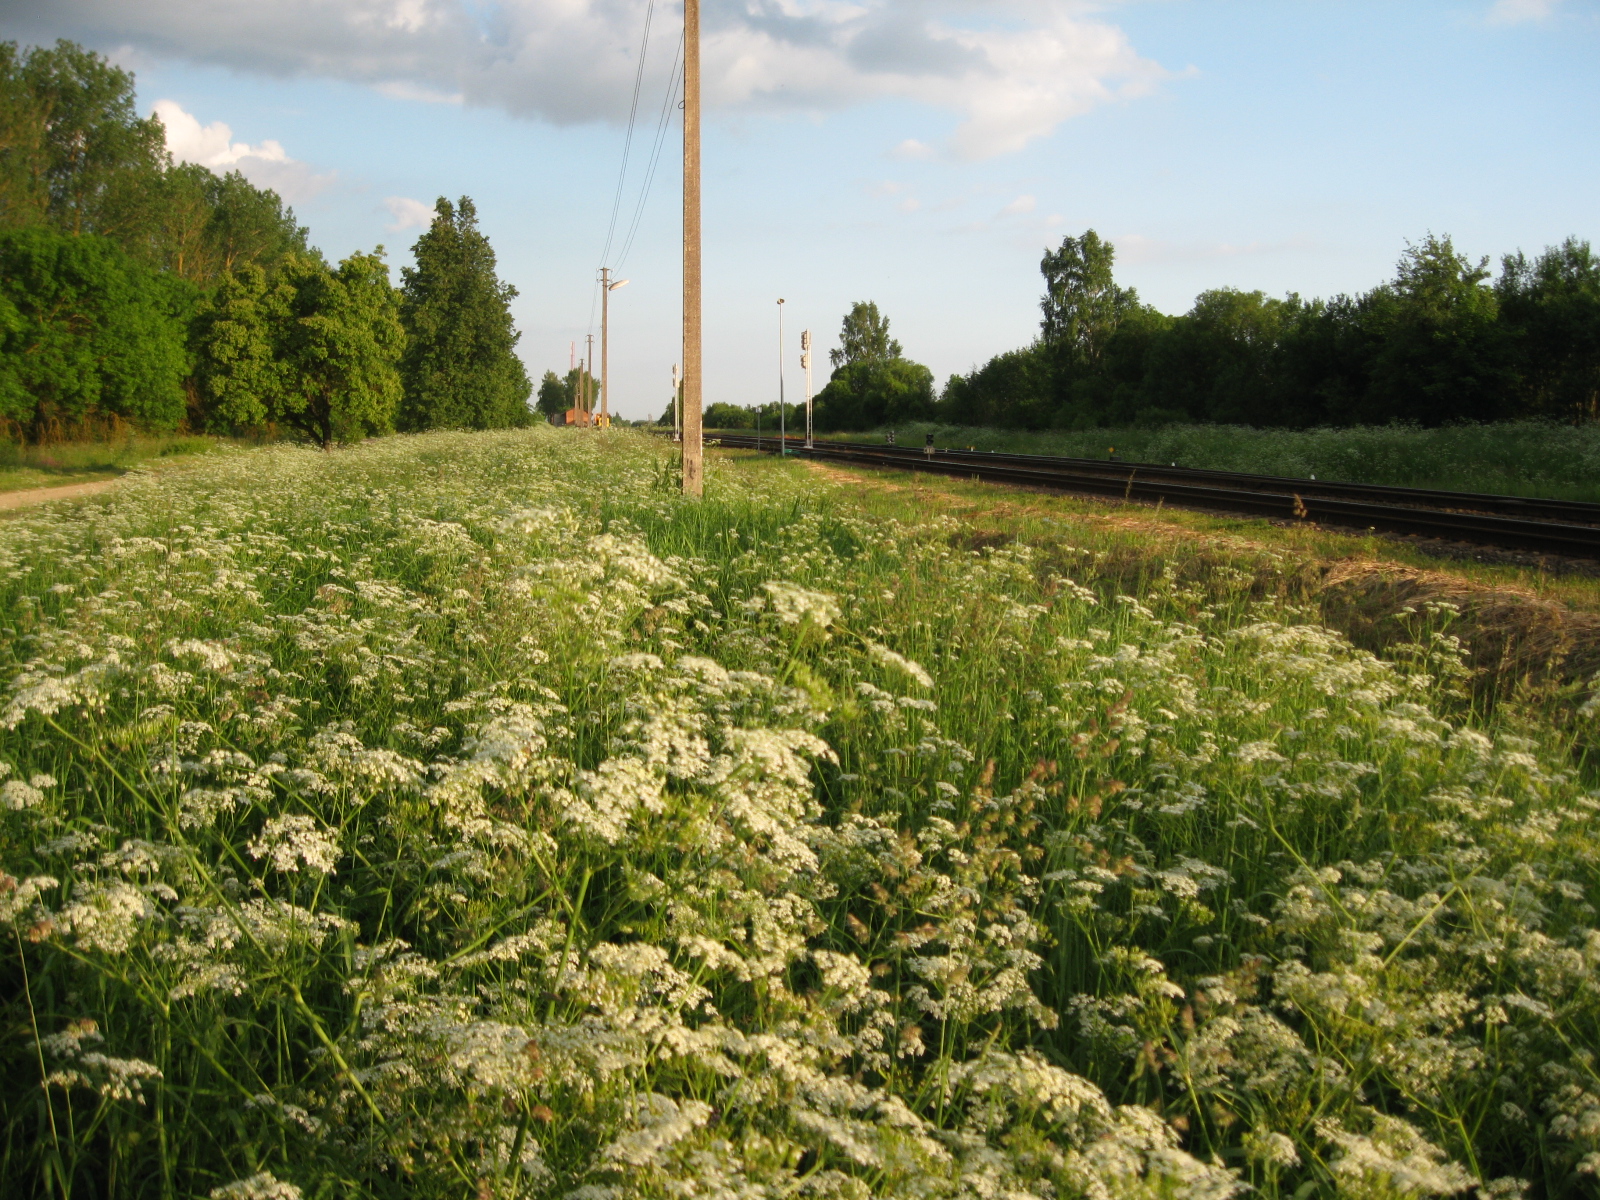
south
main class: Grassland
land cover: Spontaneously vegetated surfaces
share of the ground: > 75 %
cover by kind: herbaceous plants 100 %
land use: Railway transport
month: June
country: LT
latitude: 55.5298
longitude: 23.7886
